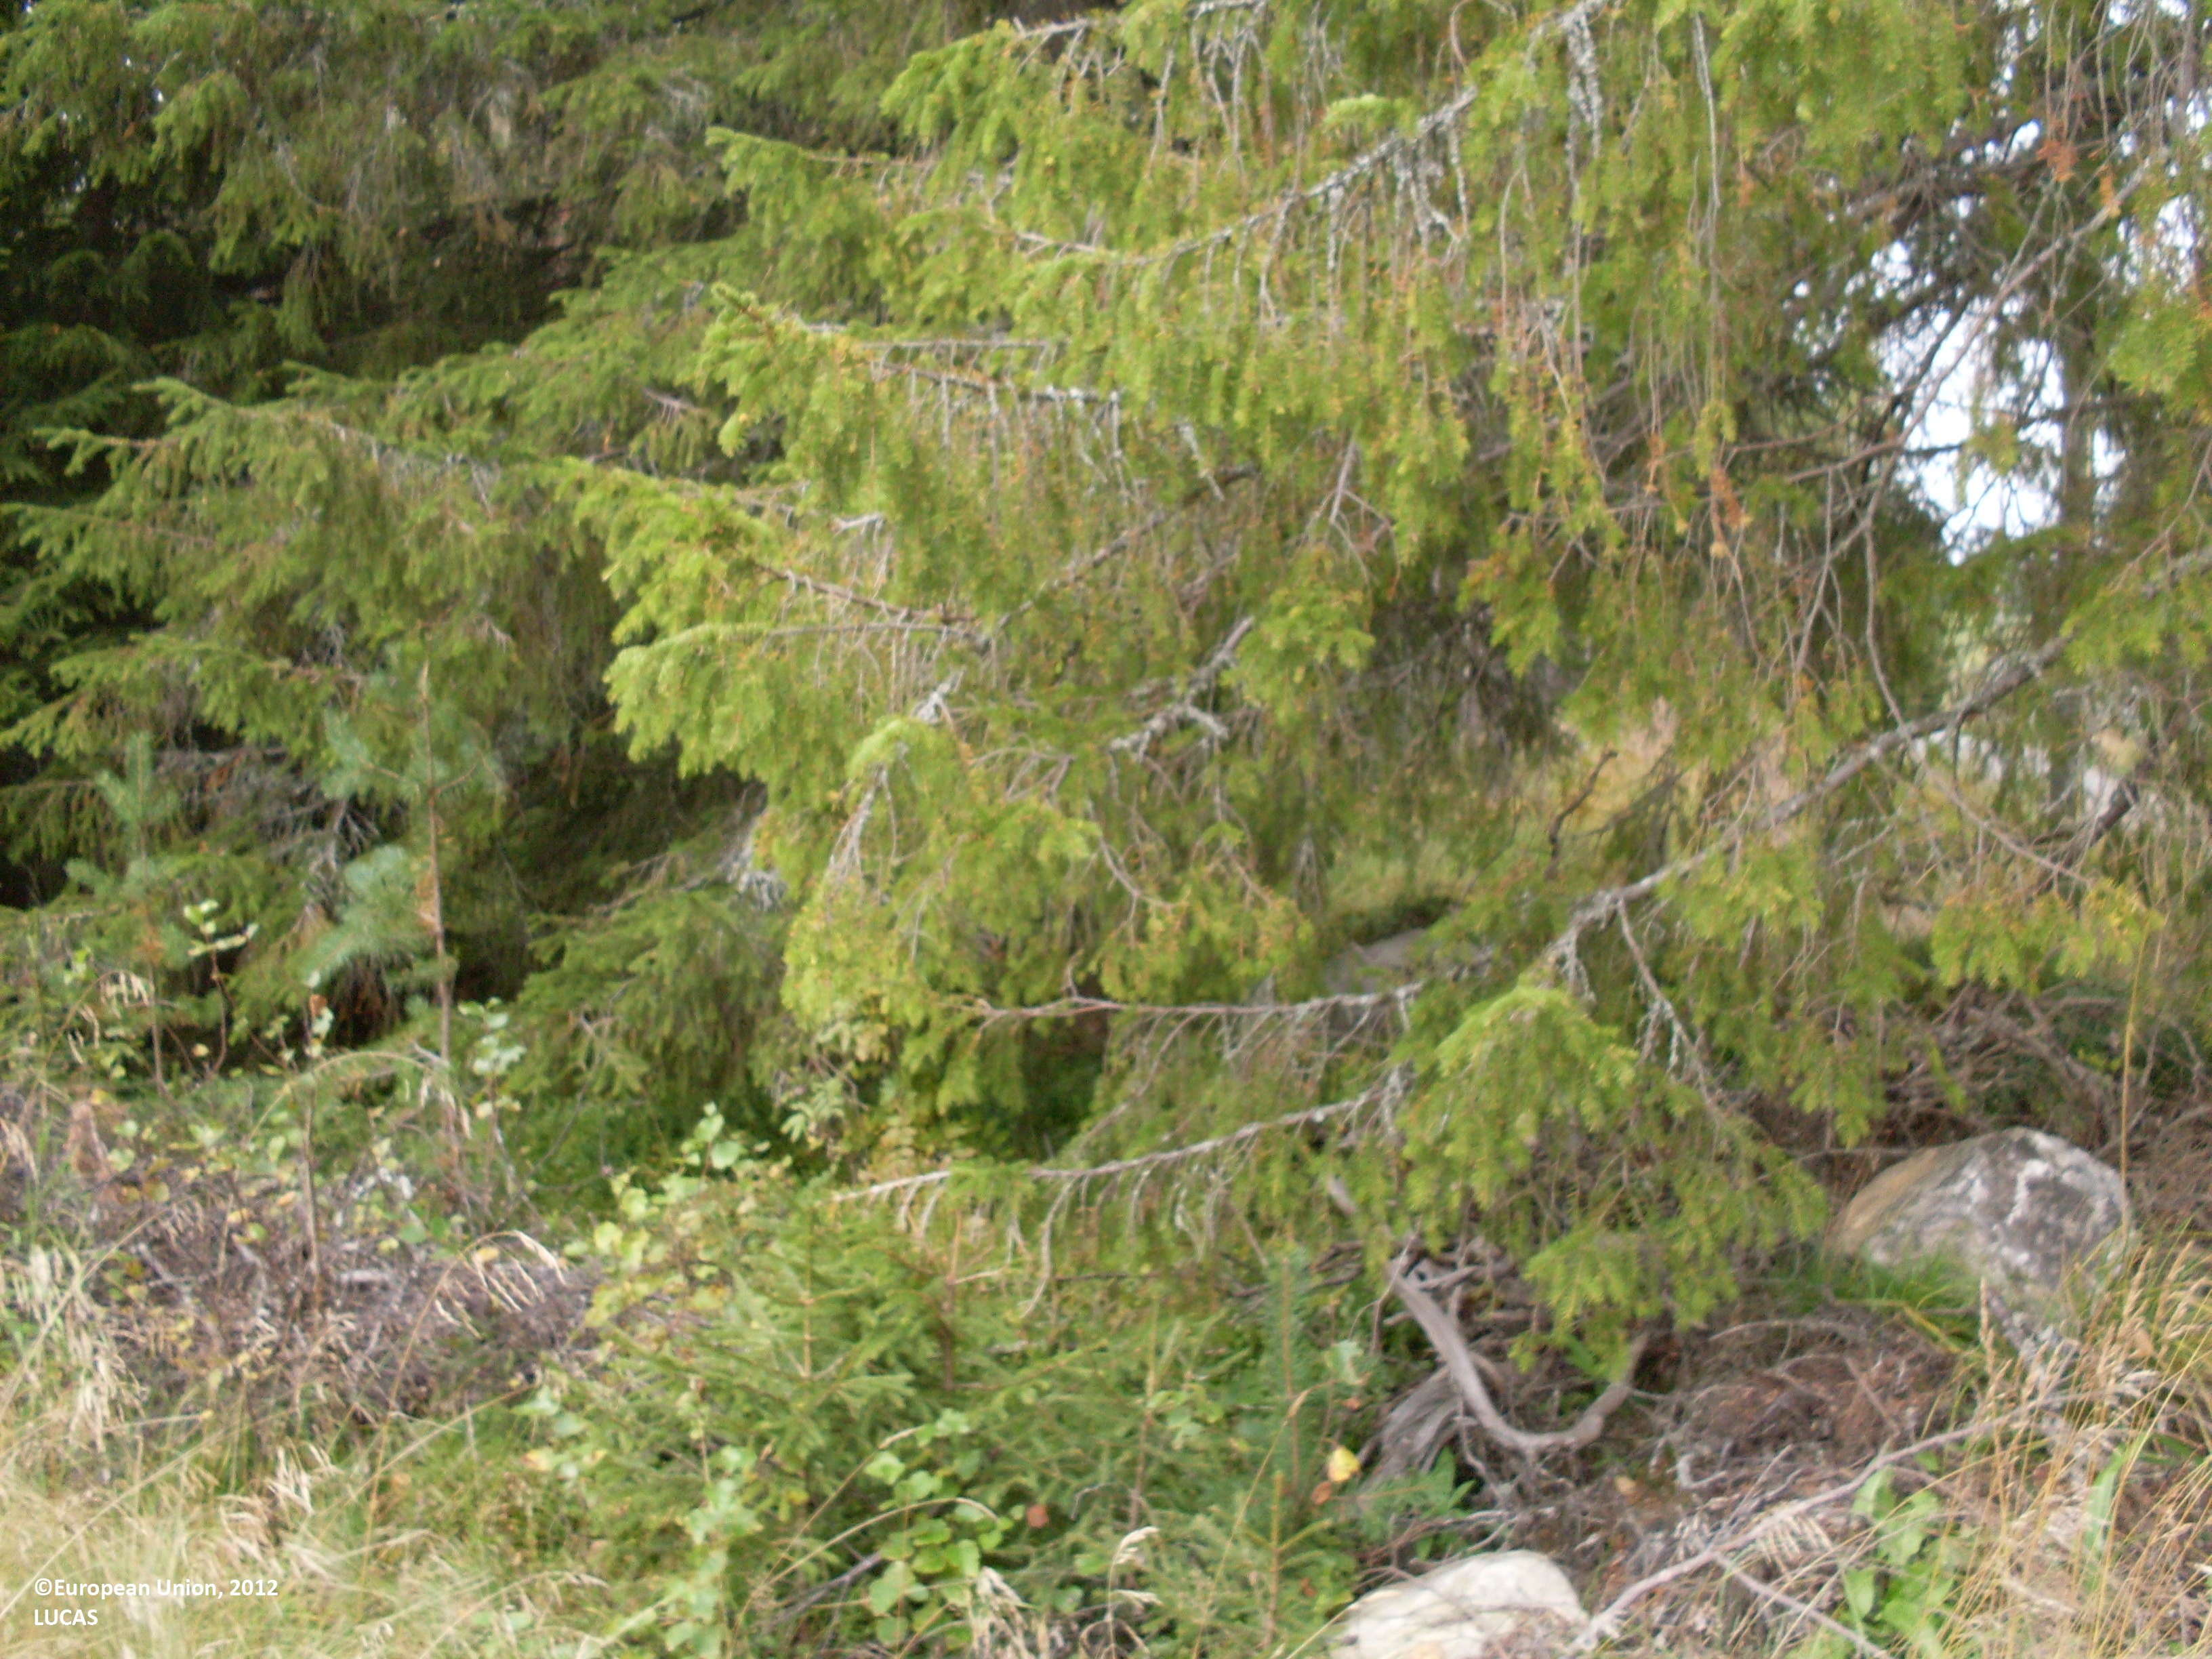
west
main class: Grassland
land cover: Grassland without tree/shrub cover
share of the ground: > 75 %
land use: Agriculture (excluding fallow land and kitchen gardens)
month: September
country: FI
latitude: 64.2554
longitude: 28.2676
